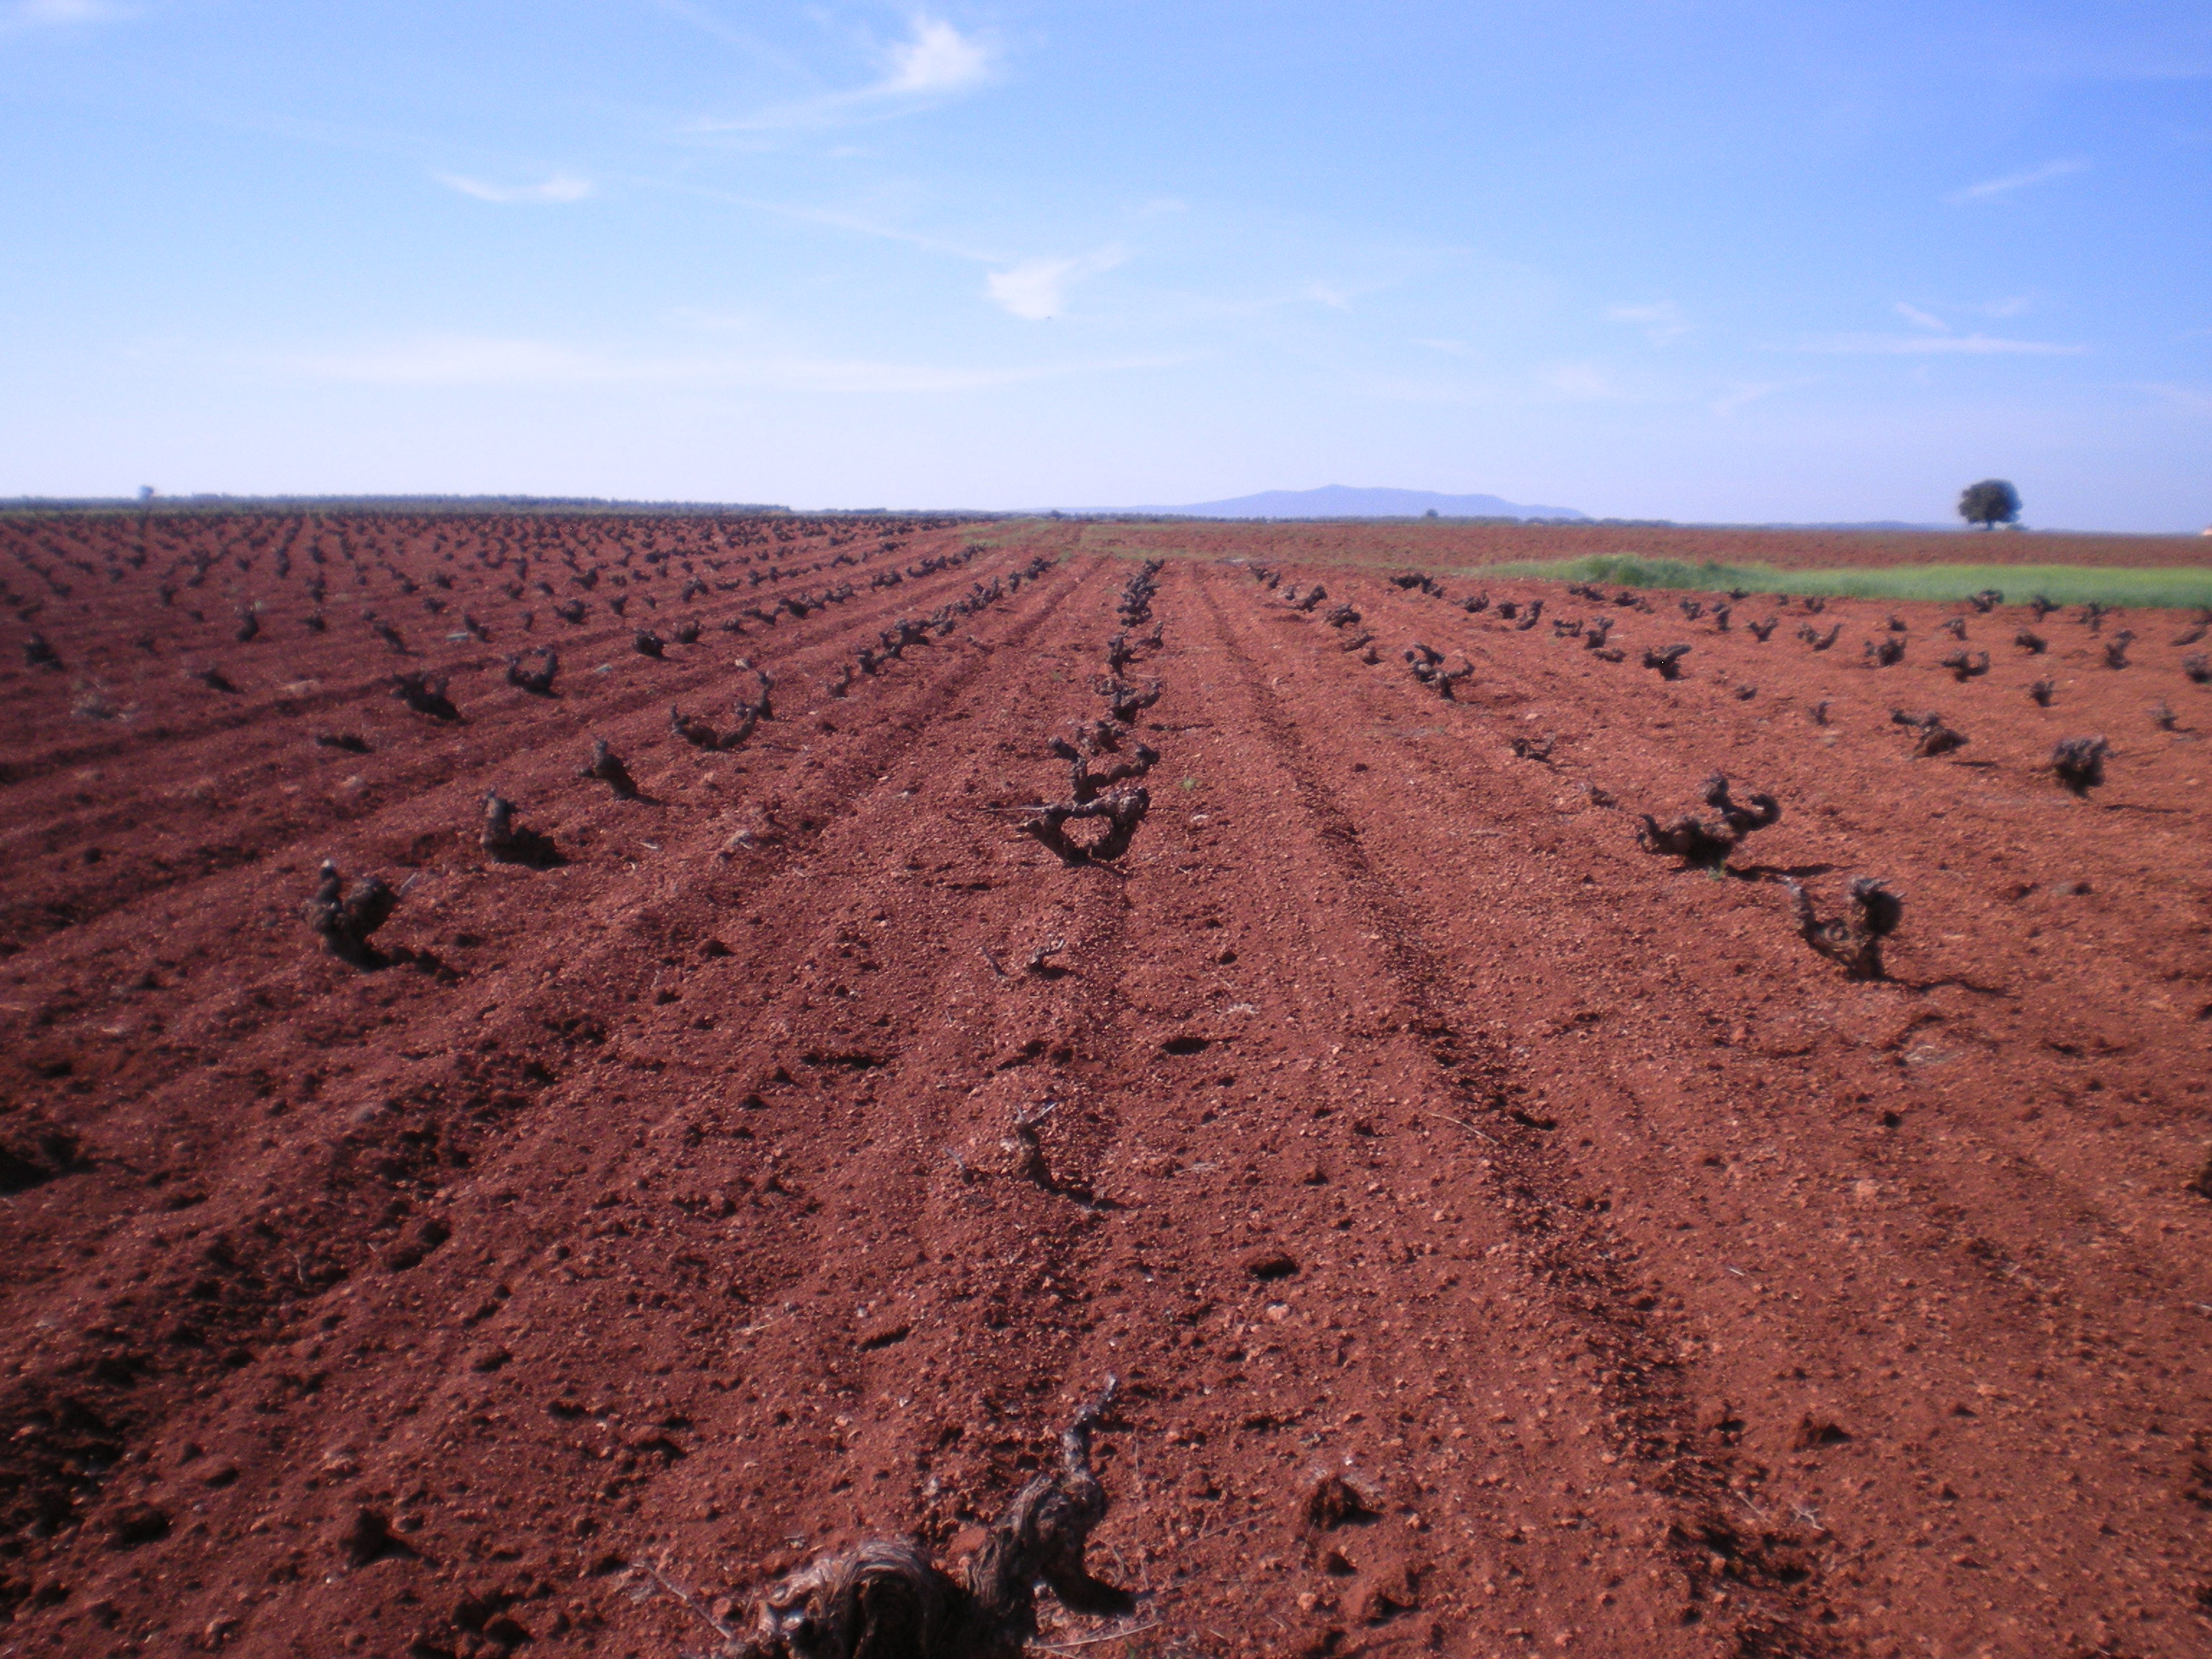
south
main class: Cropland
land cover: Vineyards
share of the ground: < 10 %
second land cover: Other bare soil
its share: > 75 %
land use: Agriculture (excluding fallow land and kitchen gardens)
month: April
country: ES
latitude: 38.8073
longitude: -3.1716
